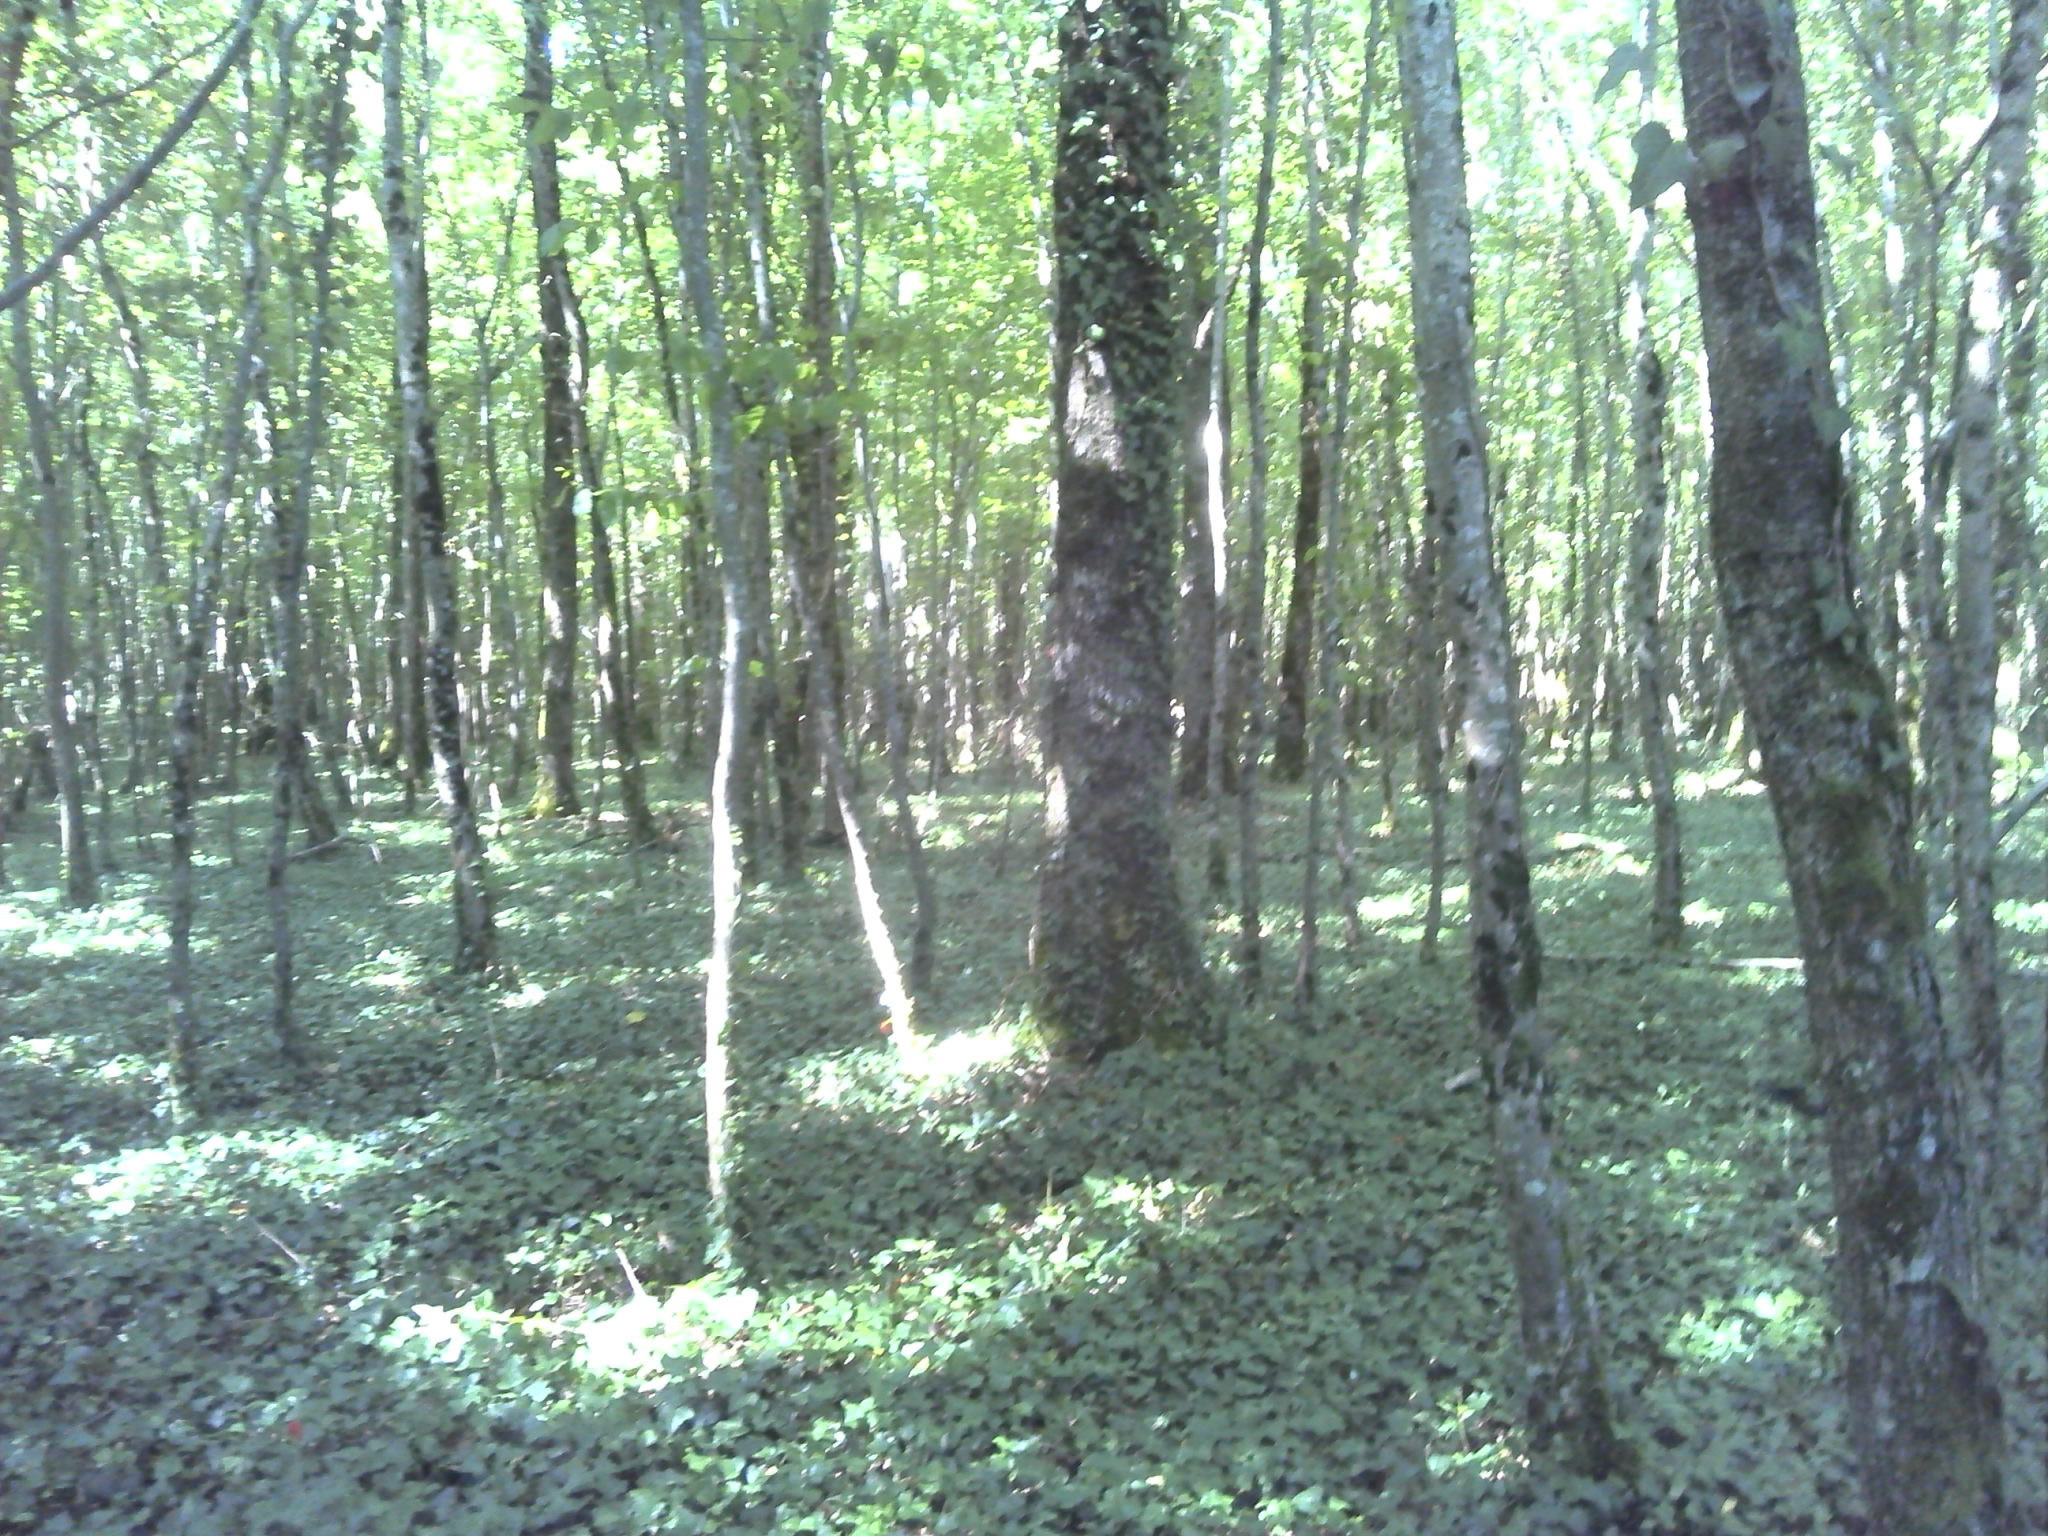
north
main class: Woodland
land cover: Broadleaved woodland
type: mesophytic deciduous forest
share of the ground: > 75 %
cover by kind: broadleaved forest trees 70 %, herbaceous plants 30 %
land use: Forestry
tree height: > 5 m
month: August
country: FR
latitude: 46.8675
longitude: 1.5533
